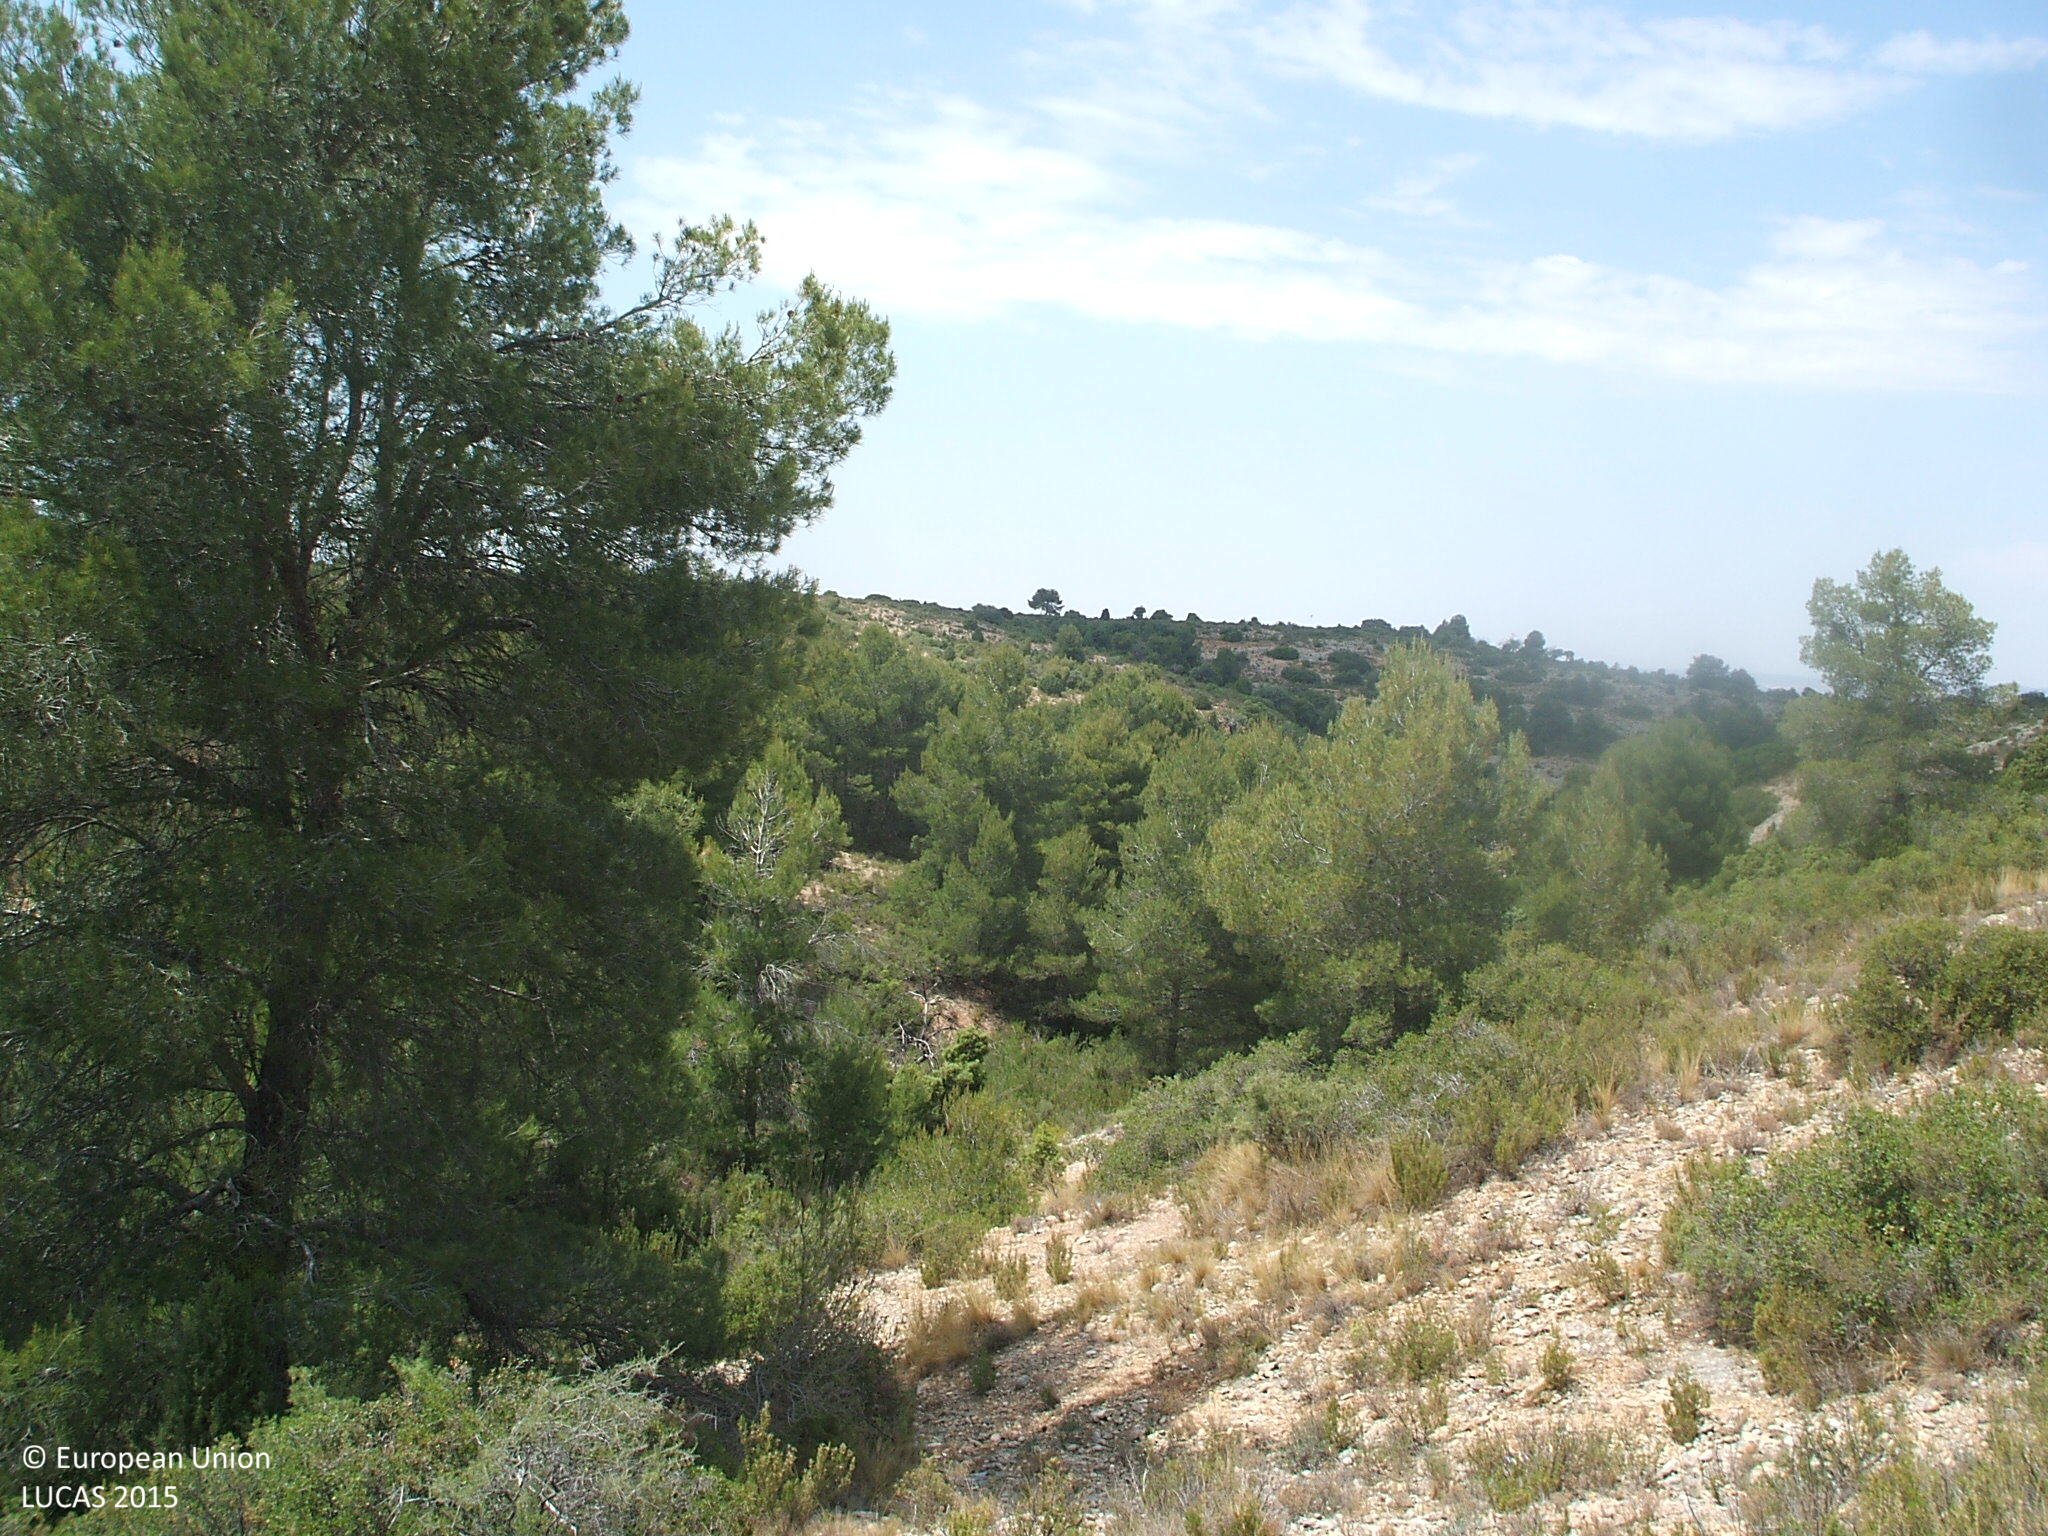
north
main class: Shrubland
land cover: Shrubland with sparse tree cover
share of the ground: 25 - 50 %
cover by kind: consolidated bare surface 75 %, shrubs 20 %, coniferous forest trees 5 %
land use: Semi-natural and natural areas not in use
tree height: < 5 m
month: June
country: ES
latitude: 40.8913
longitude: -0.1104
